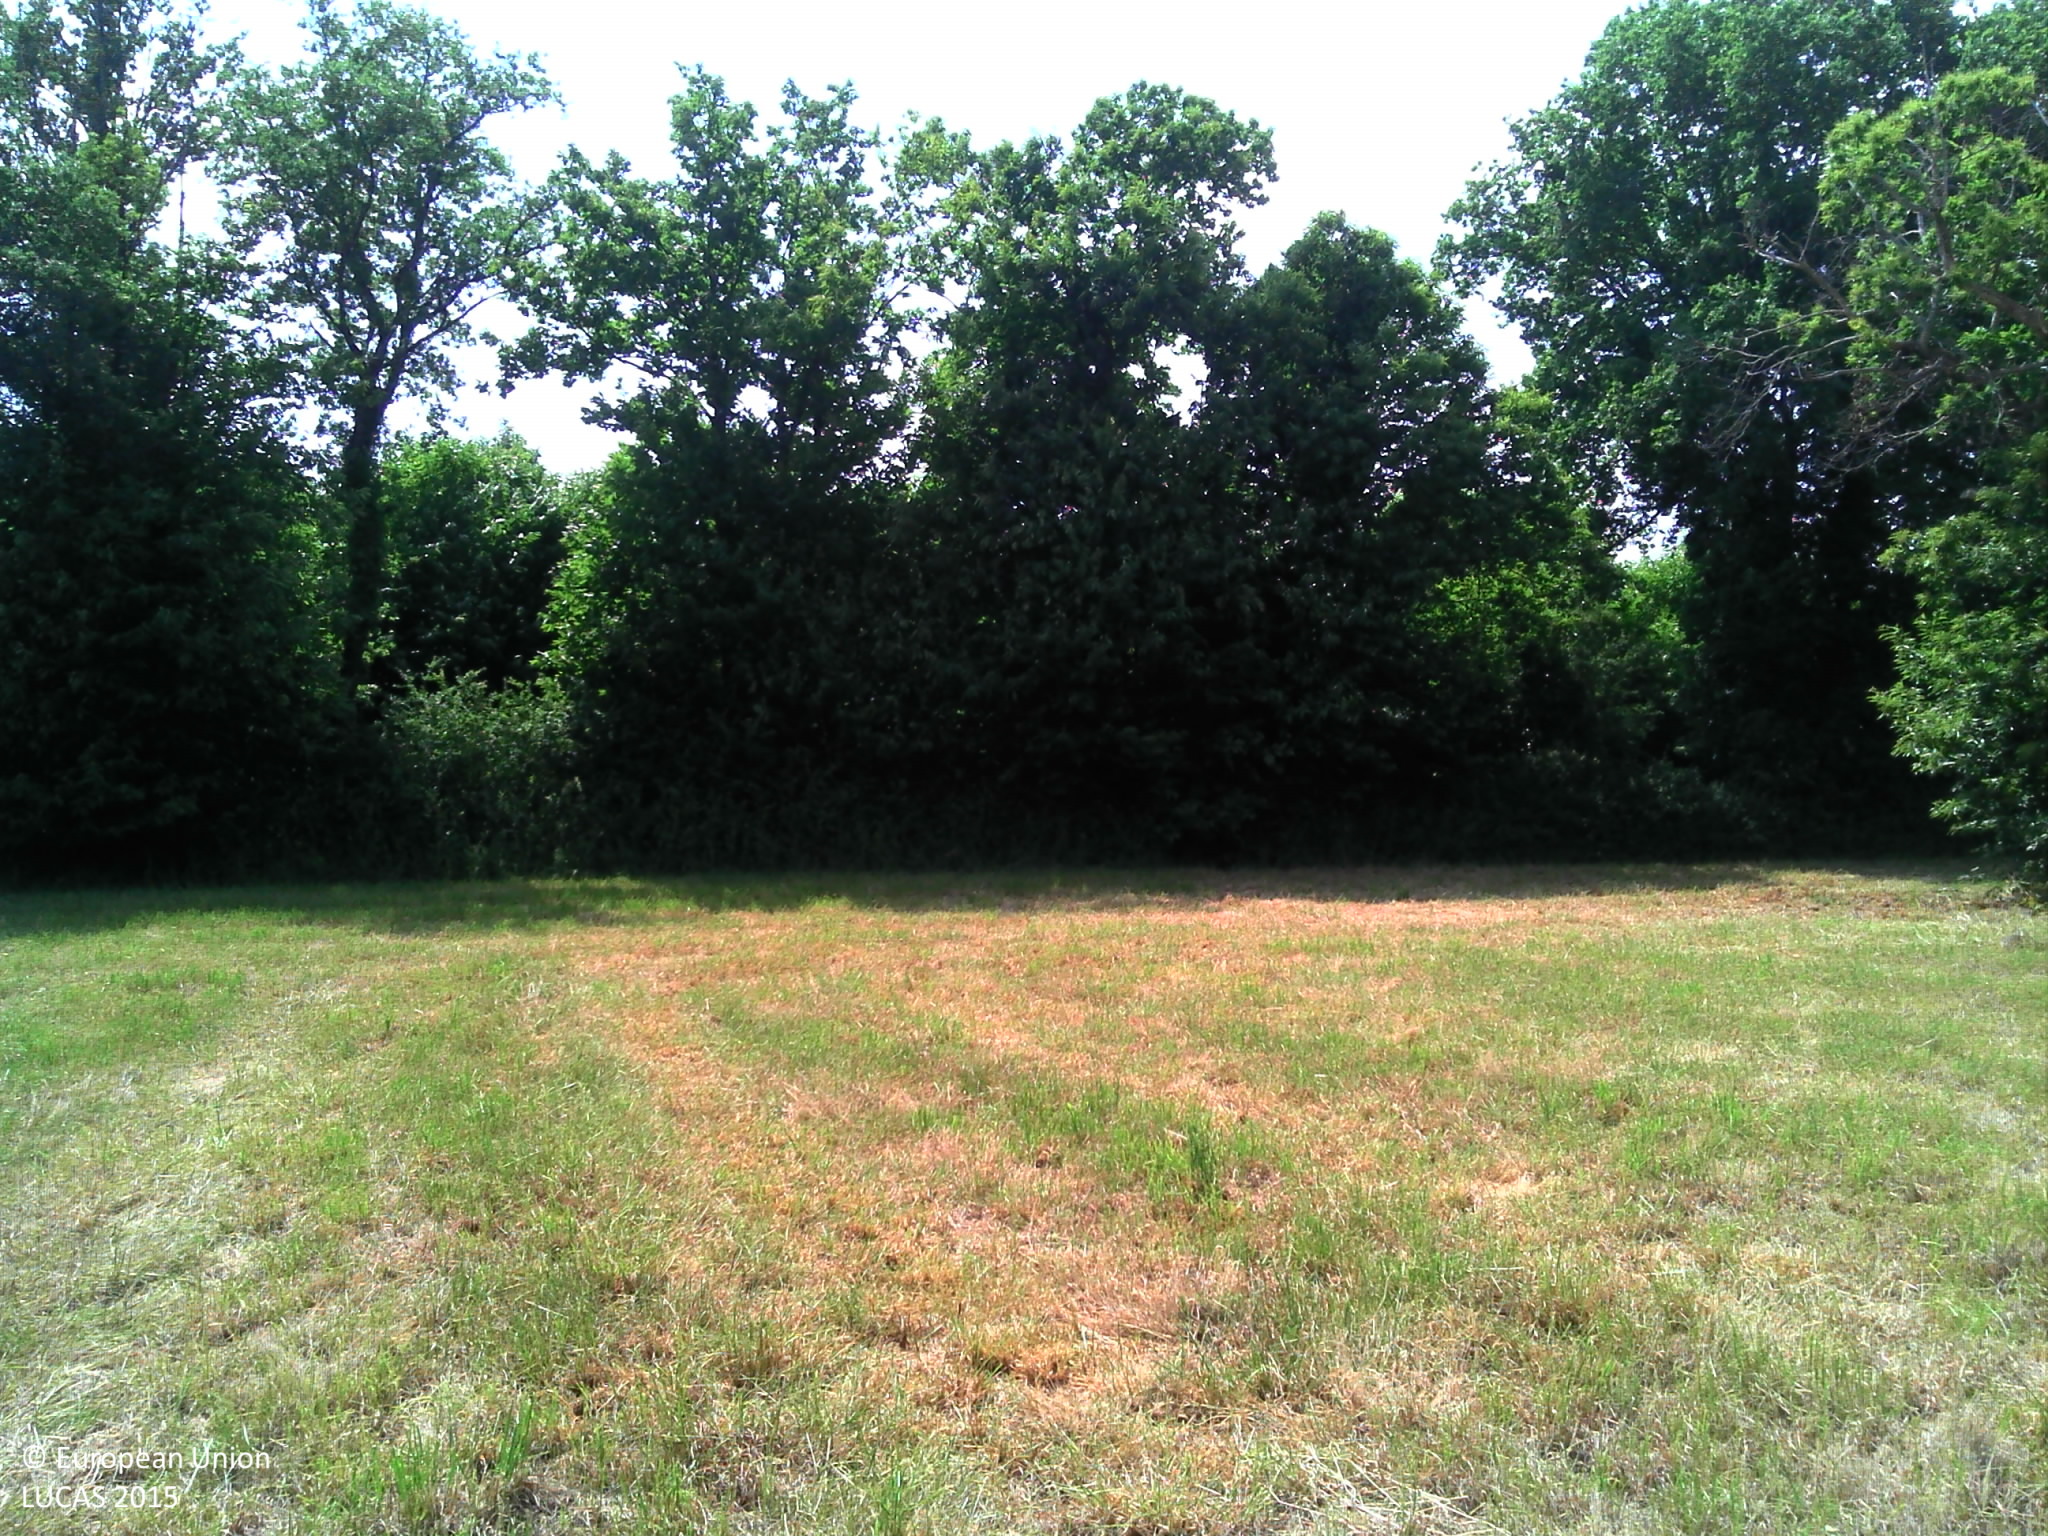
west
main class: Grassland
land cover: Grassland without tree/shrub cover
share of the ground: > 75 %
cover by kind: herbaceous plants 100 %
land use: Agriculture (excluding fallow land and kitchen gardens)
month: June
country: FR
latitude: 45.9344
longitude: 0.3756
